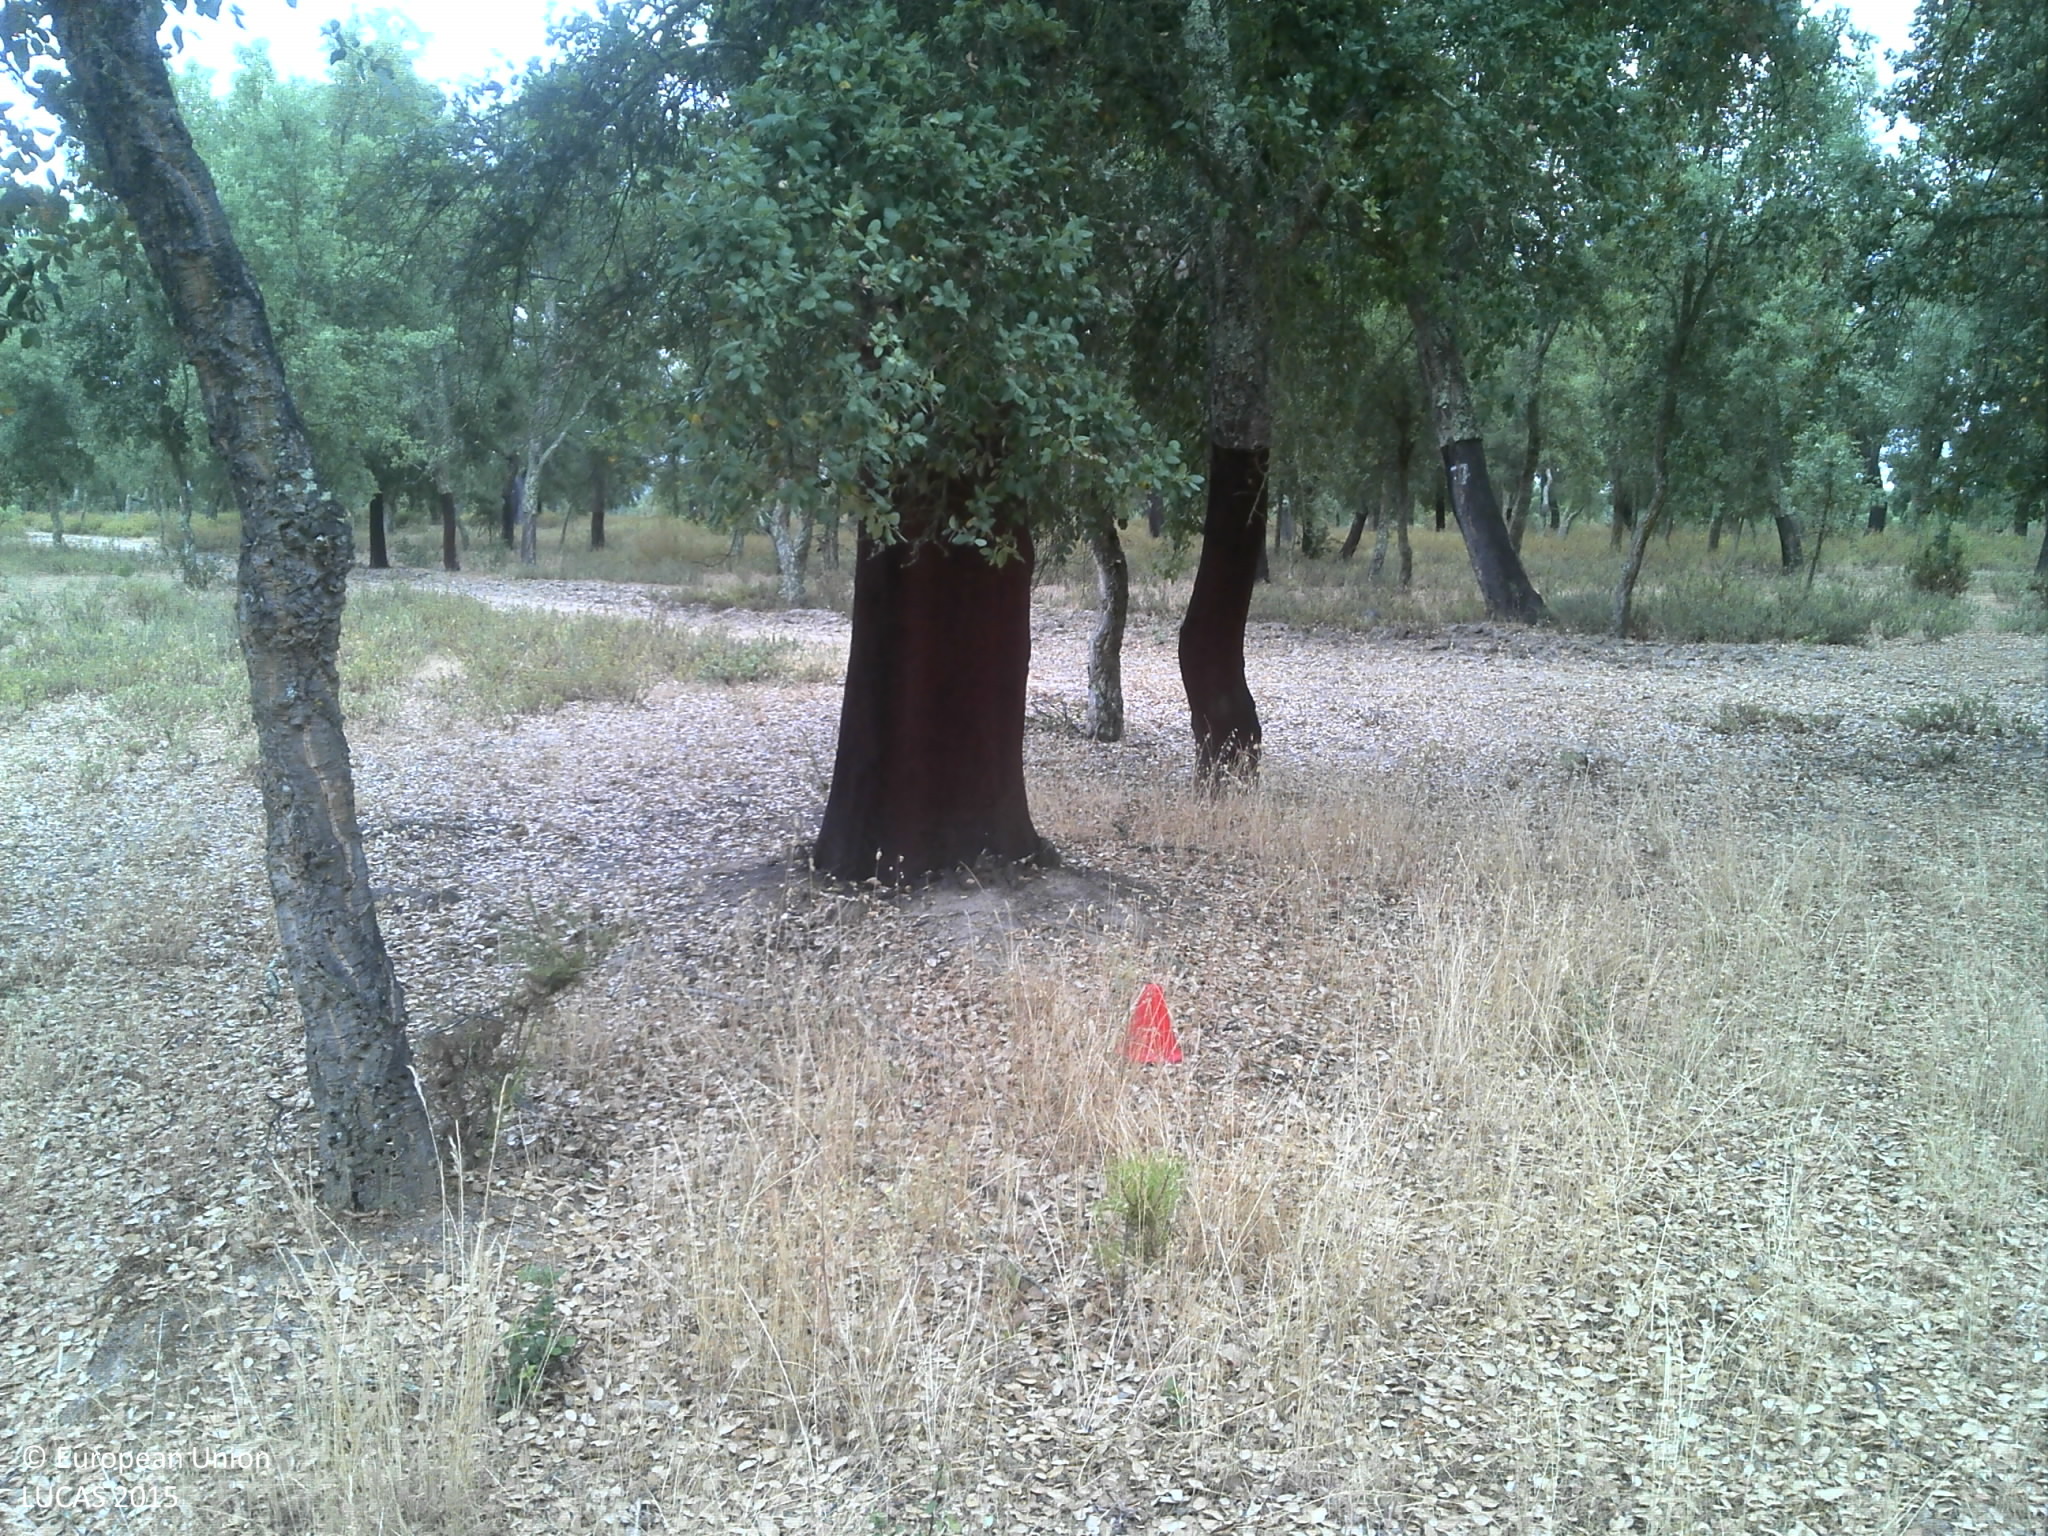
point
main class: Woodland
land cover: Broadleaved woodland
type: broadleaved evergreen forest
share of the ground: 25 - 50 %
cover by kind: broadleaved forest trees 50 %, herbaceous plants 25 %, unconsolidated bare surface 20 %, shrubs 5 %
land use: Forestry
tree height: > 5 m
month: June
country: PT
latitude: 39.2649
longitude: -8.0318
